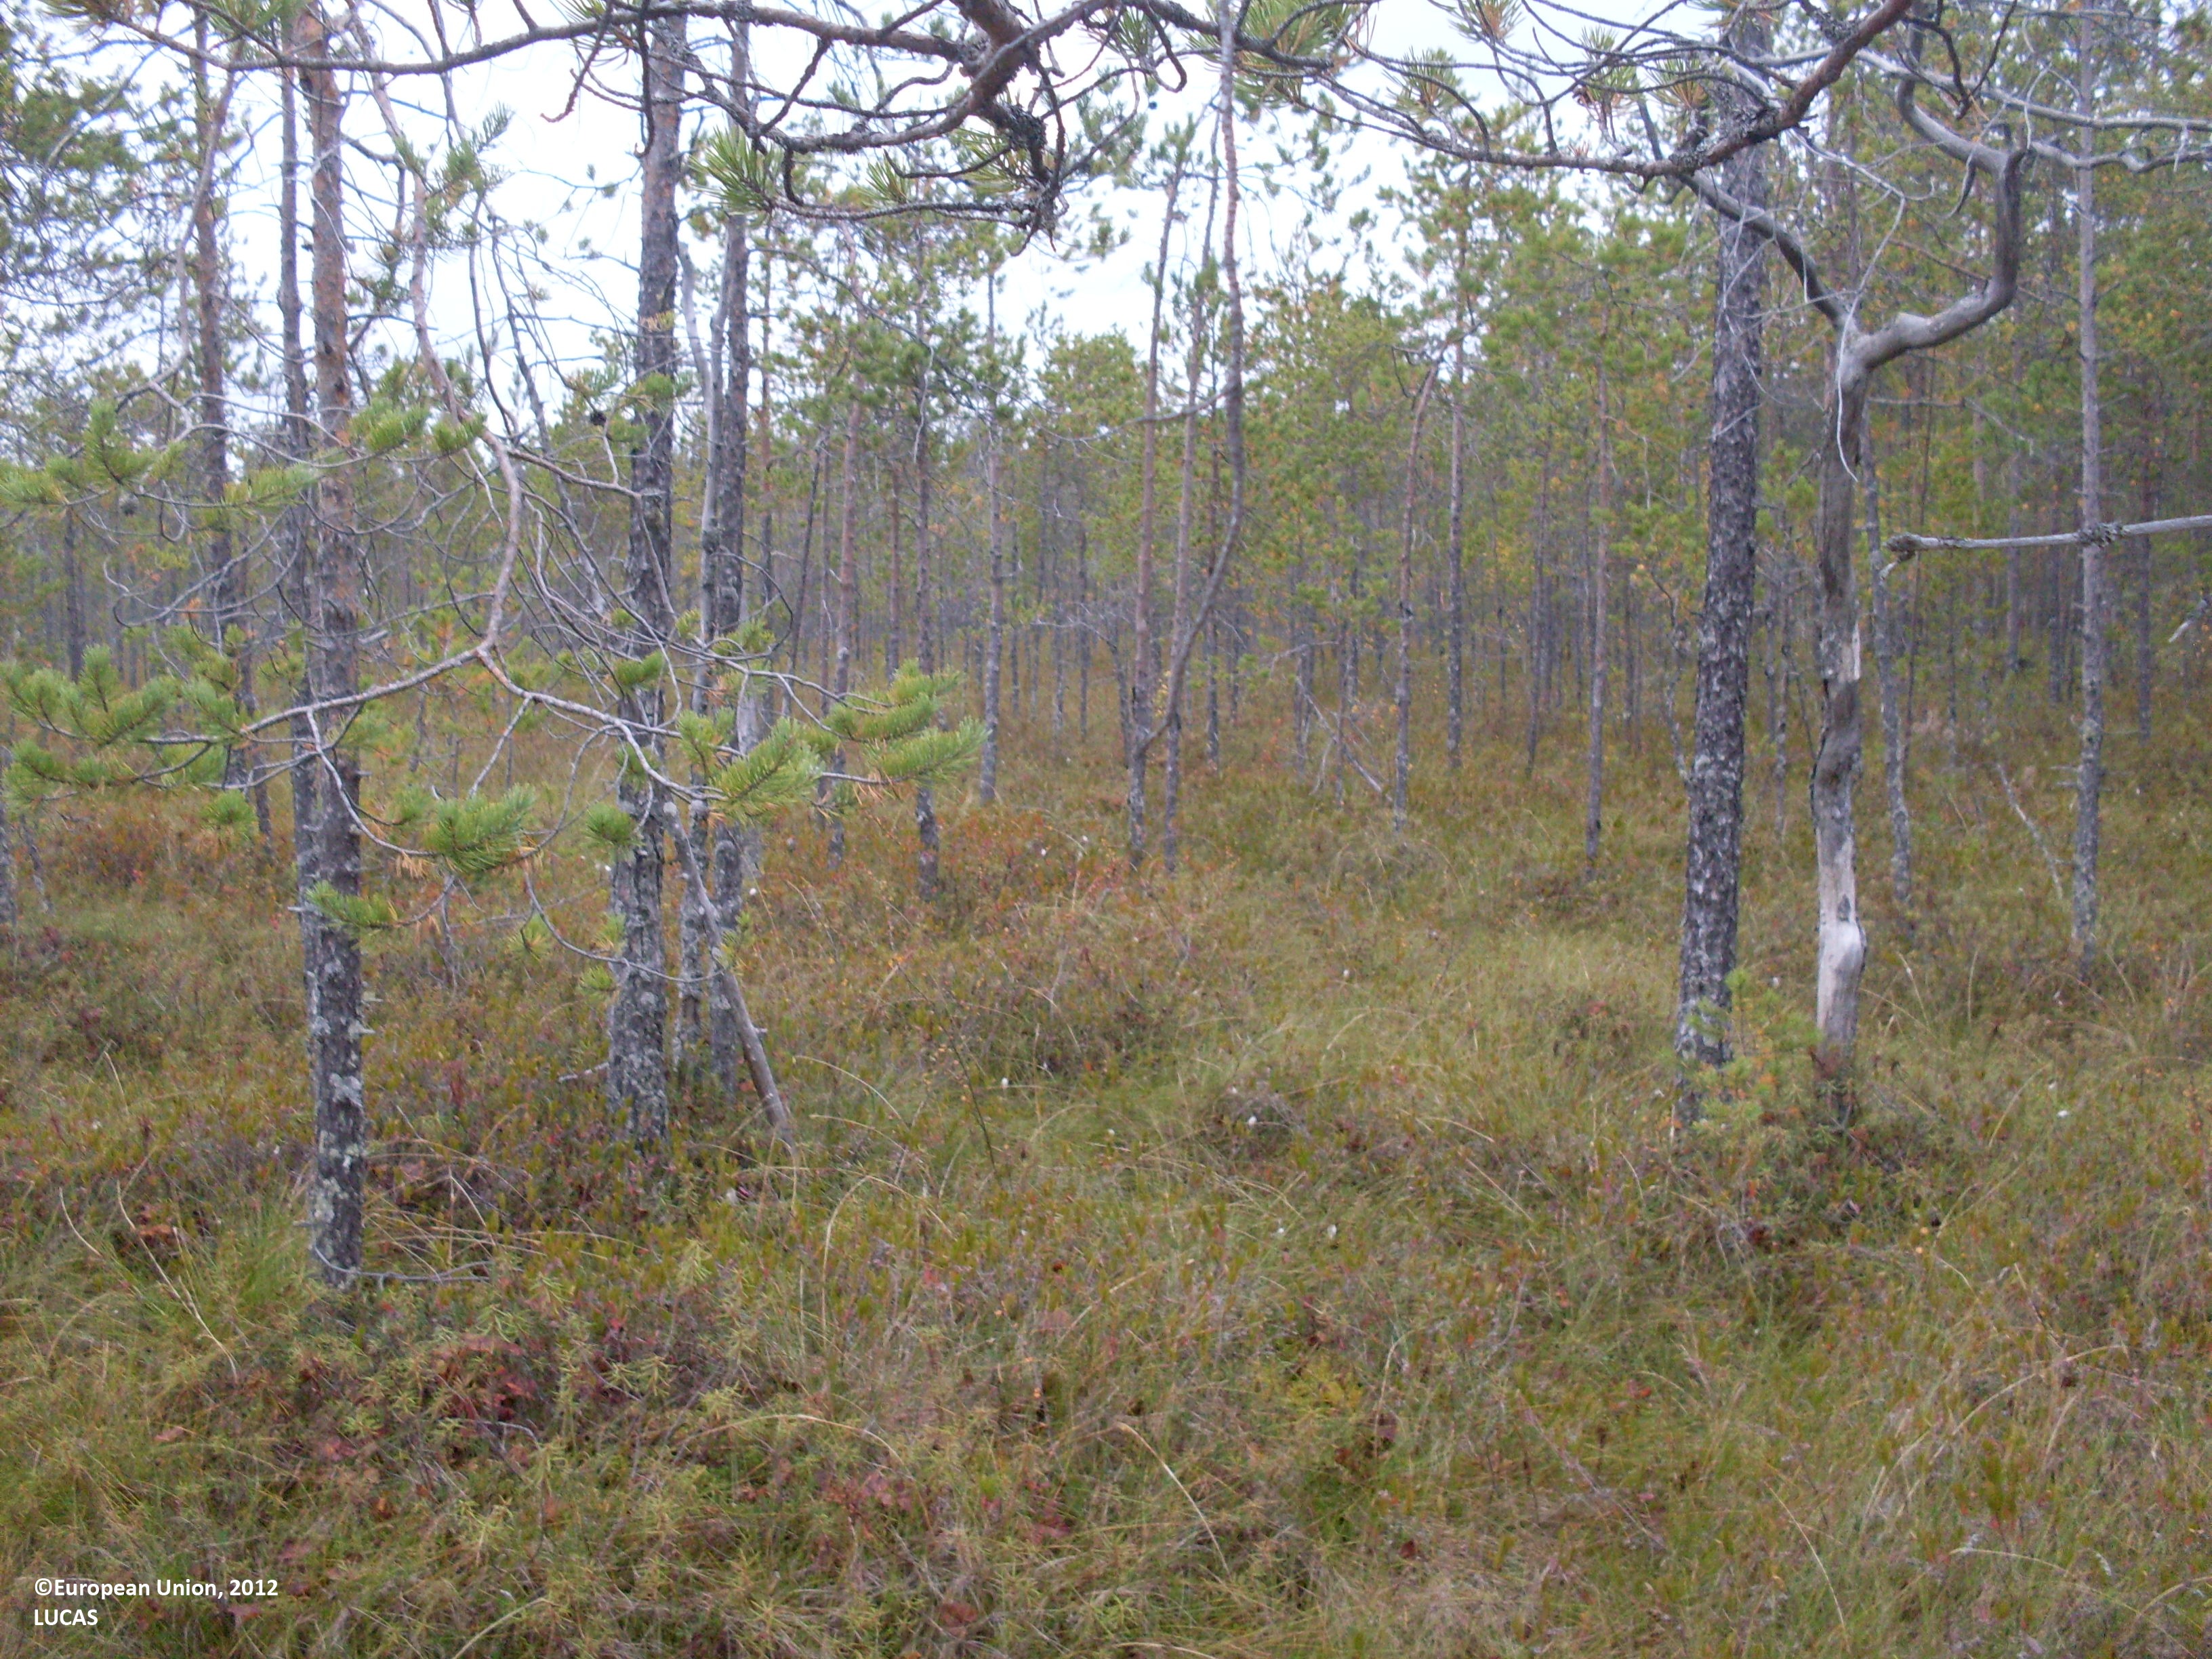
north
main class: Woodland
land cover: Pine dominated coniferous woodland
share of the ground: 10 - 25 %
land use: Semi-natural and natural areas not in use
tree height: < 5 m
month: September
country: FI
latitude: 64.1529
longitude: 29.2666
